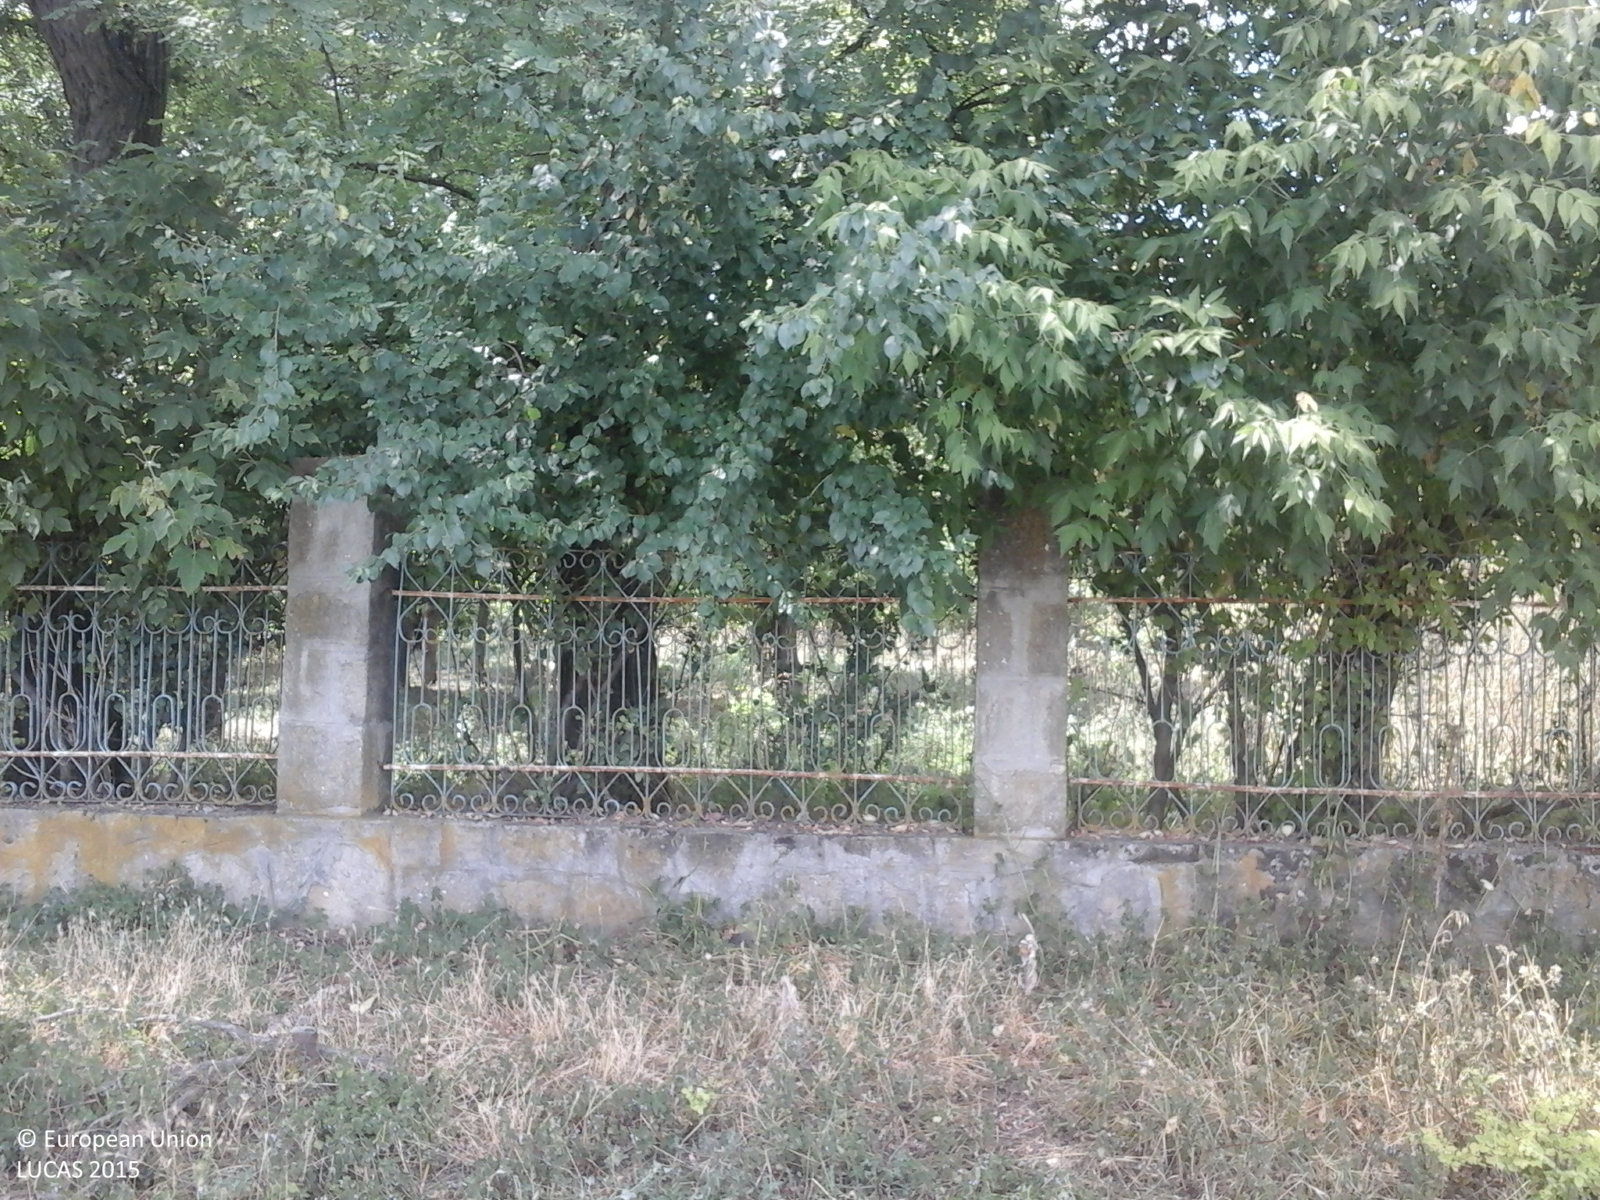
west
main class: Grassland
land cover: Grassland without tree/shrub cover
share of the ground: > 75 %
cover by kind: herbaceous plants 100 %
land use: Residential
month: July
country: RO
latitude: 46.4704
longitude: 28.1957
